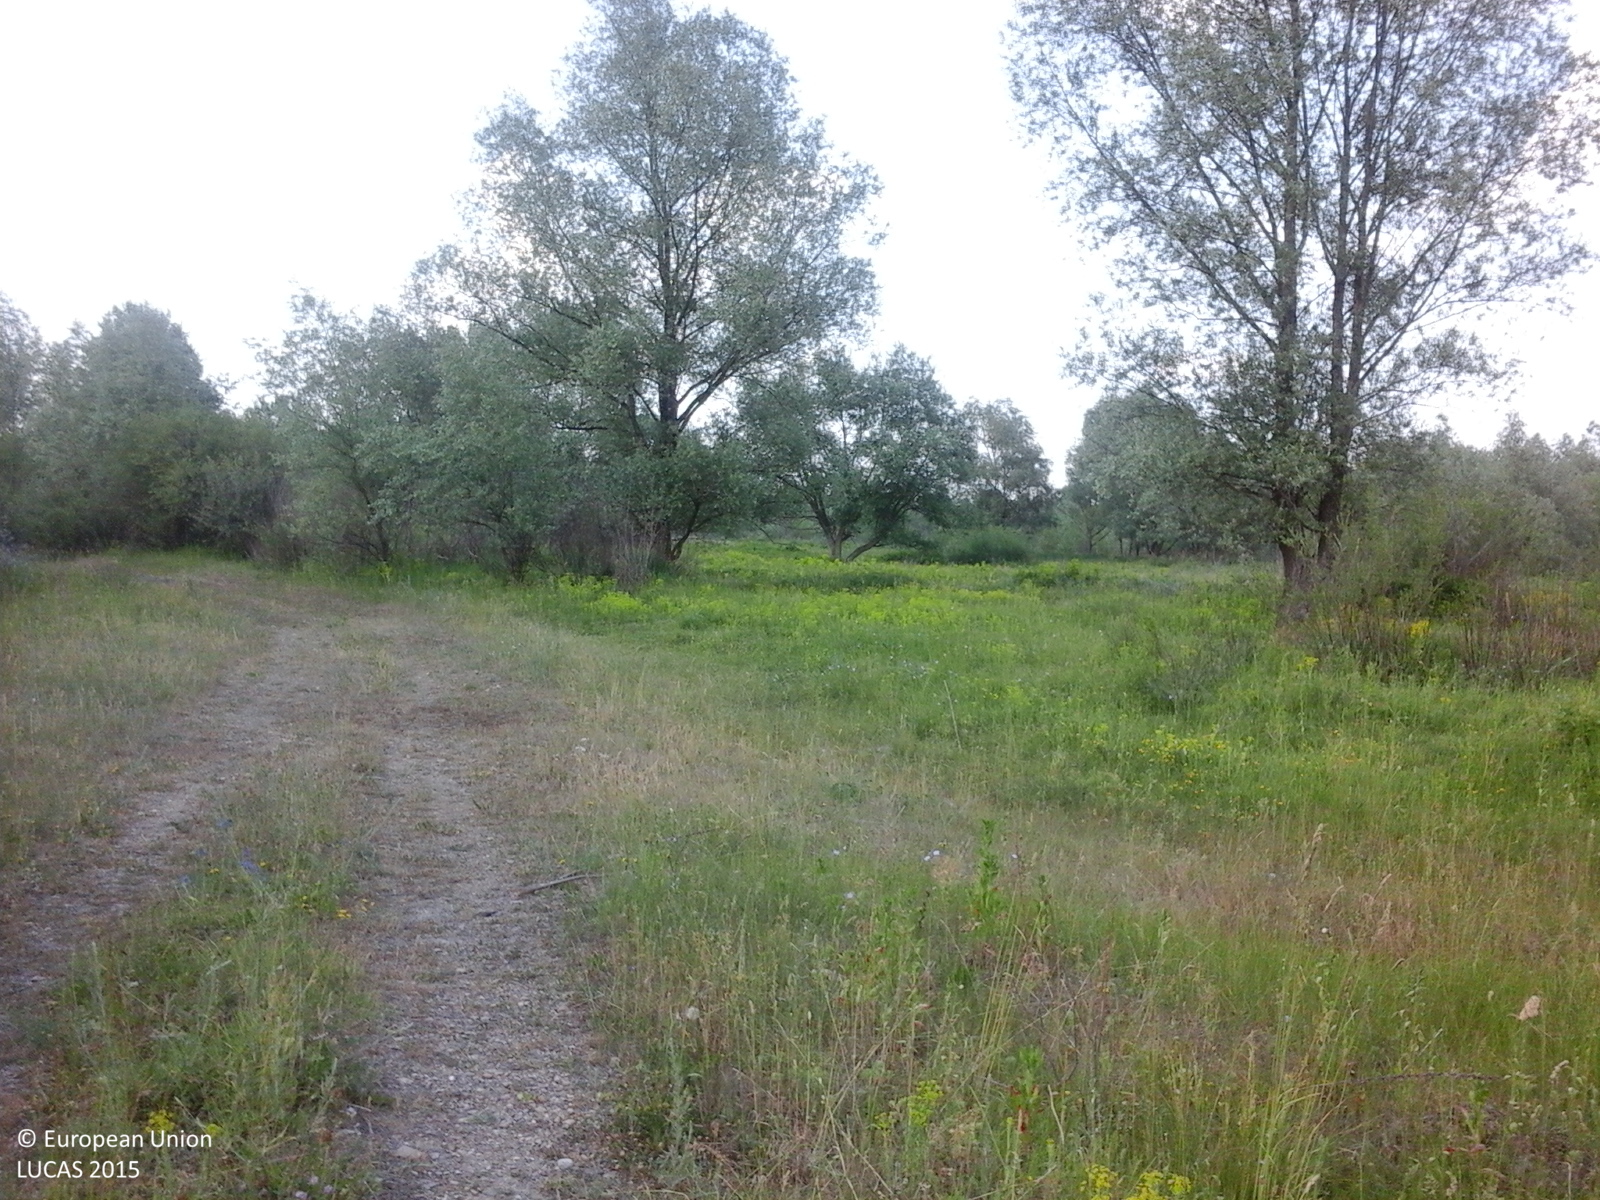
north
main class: Grassland
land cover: Grassland with sparse tree/shrub cover
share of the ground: > 75 %
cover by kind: herbaceous plants 90 %, broadleaved forest trees 5 %, shrubs 5 %
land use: Agriculture (excluding fallow land and kitchen gardens)
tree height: < 5 m
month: June
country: RO
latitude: 46.4791
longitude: 26.6944
